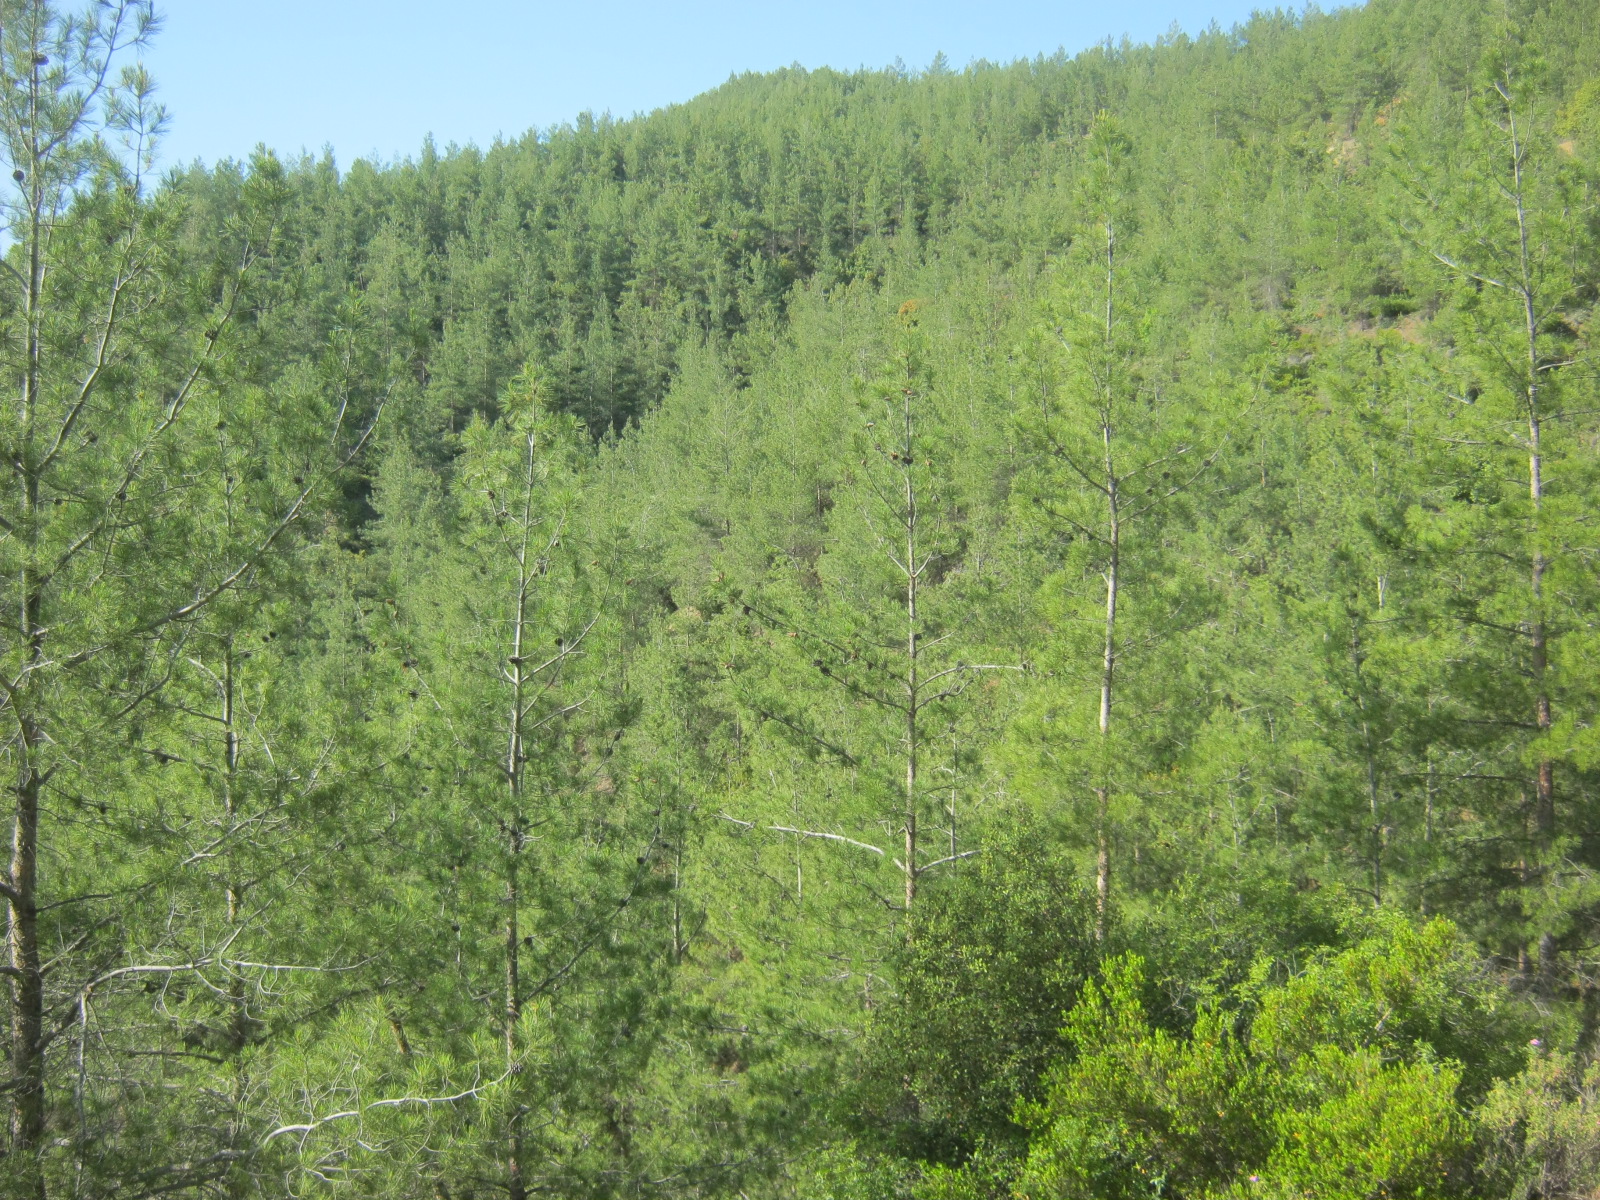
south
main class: Woodland
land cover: Pine dominated coniferous woodland
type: coniferous forest of the mediterranean region
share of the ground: 50 - 75 %
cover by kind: coniferous forest trees 50 %, unconsolidated bare surface 35 %, shrubs 15 %
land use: Forestry
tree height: > 5 m
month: May
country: CY
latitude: 35.0319
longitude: 32.8017
